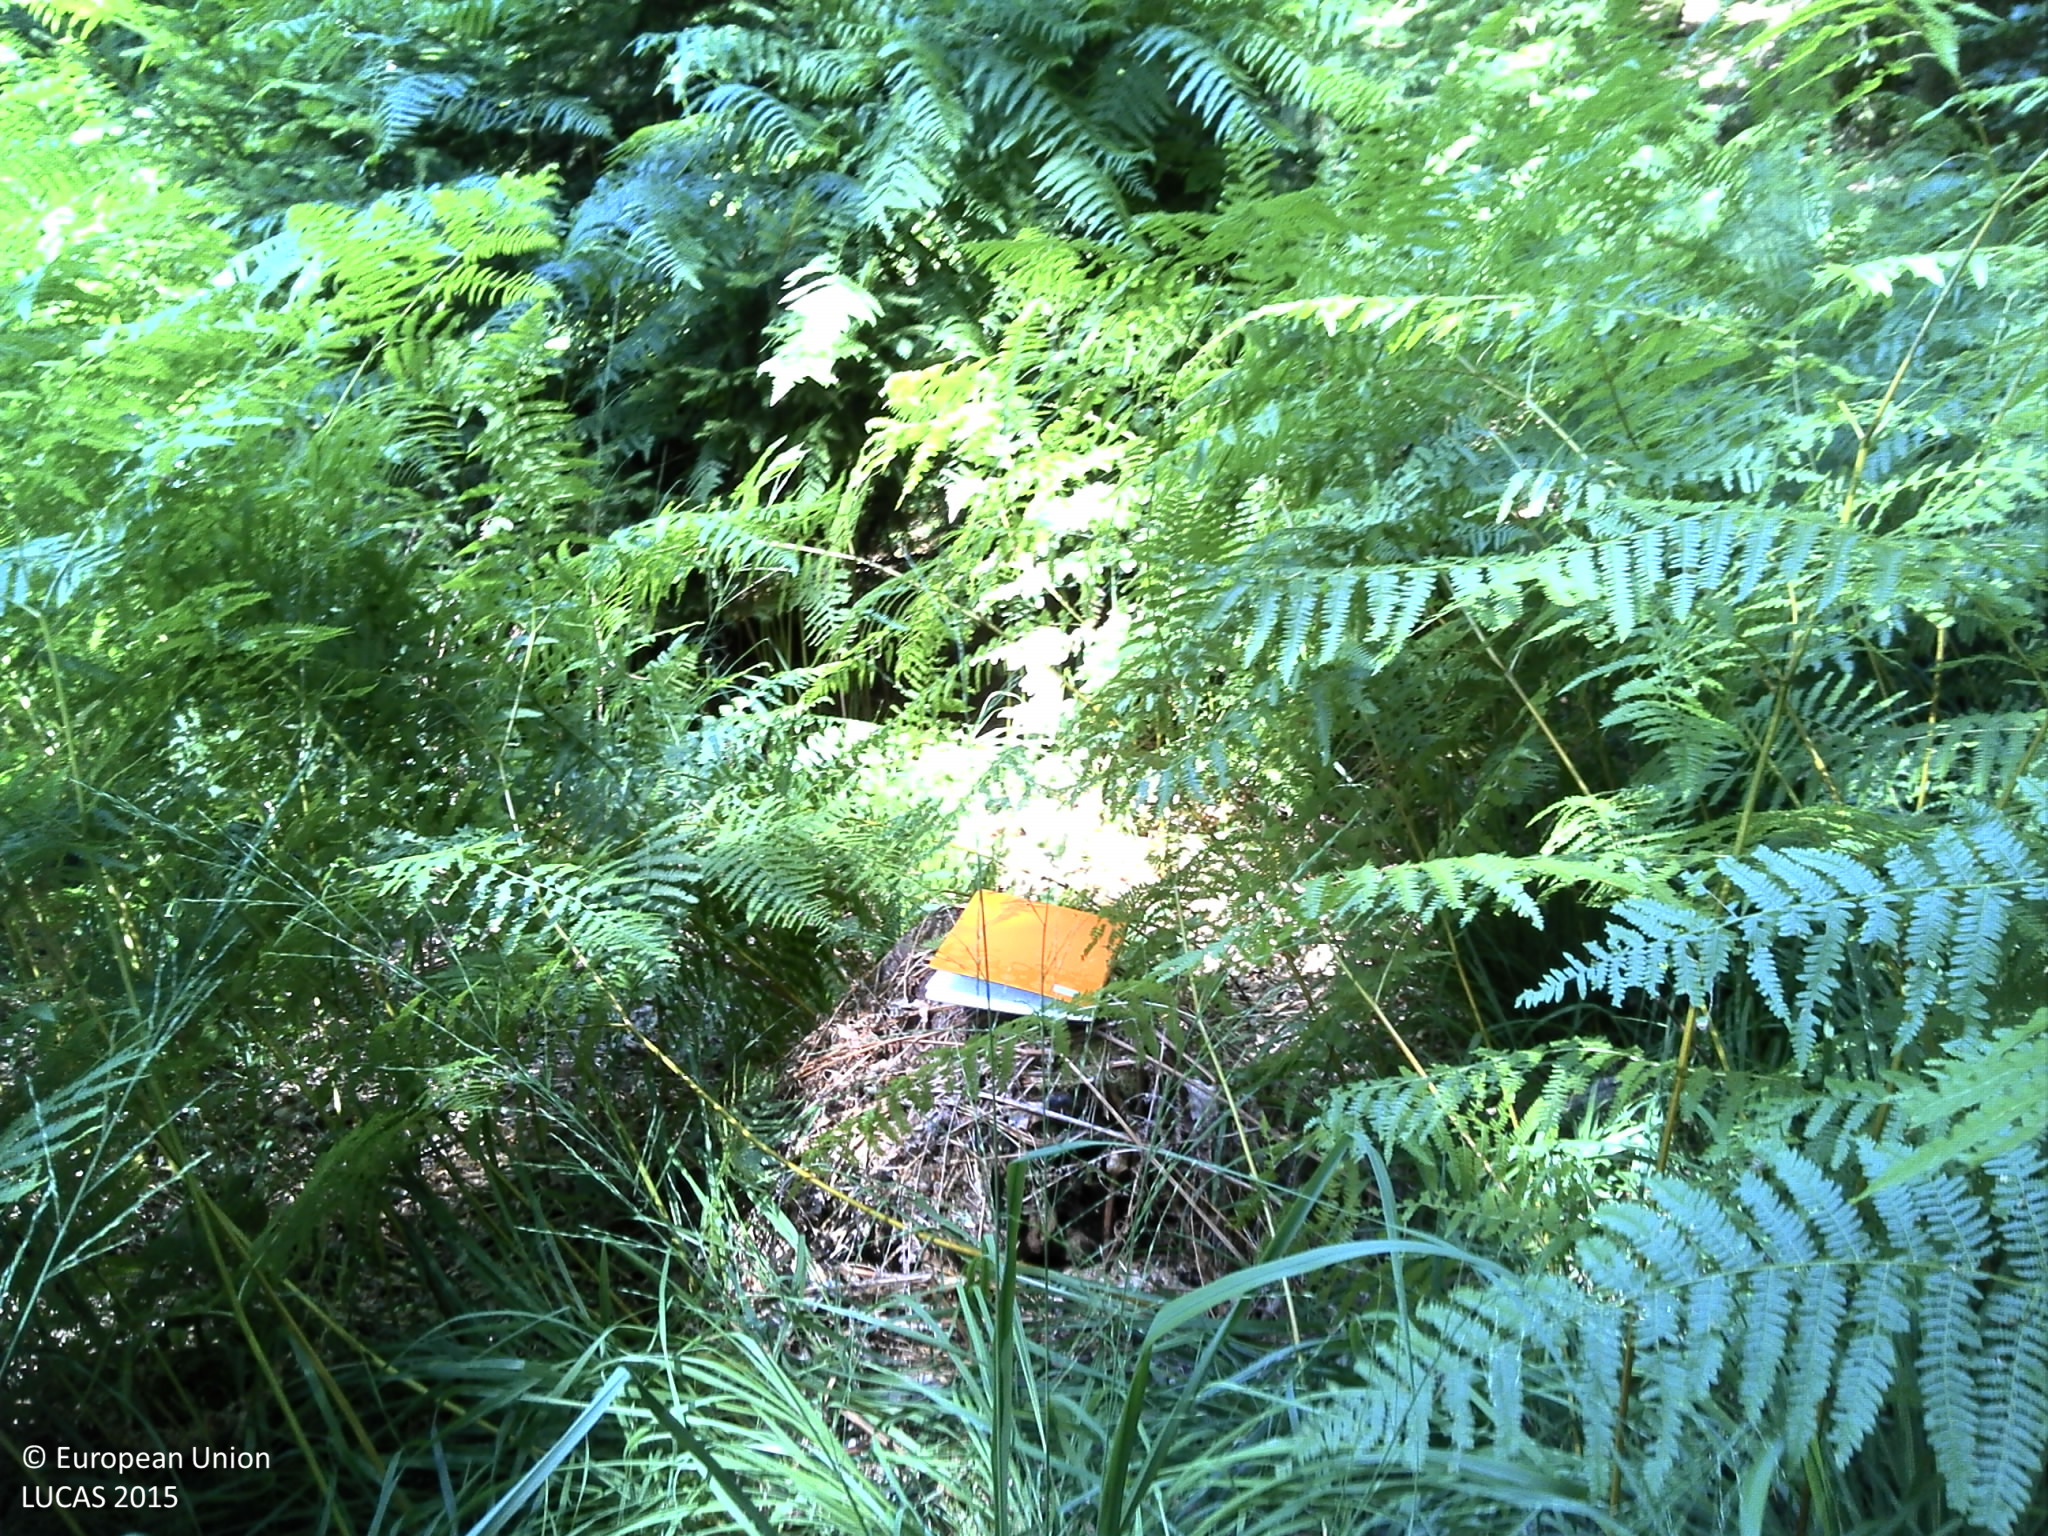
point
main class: Woodland
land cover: Broadleaved woodland
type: beech forest
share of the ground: > 75 %
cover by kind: broadleaved forest trees 100 %
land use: Forestry
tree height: > 5 m
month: July
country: FR
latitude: 48.1154
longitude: 6.0110
